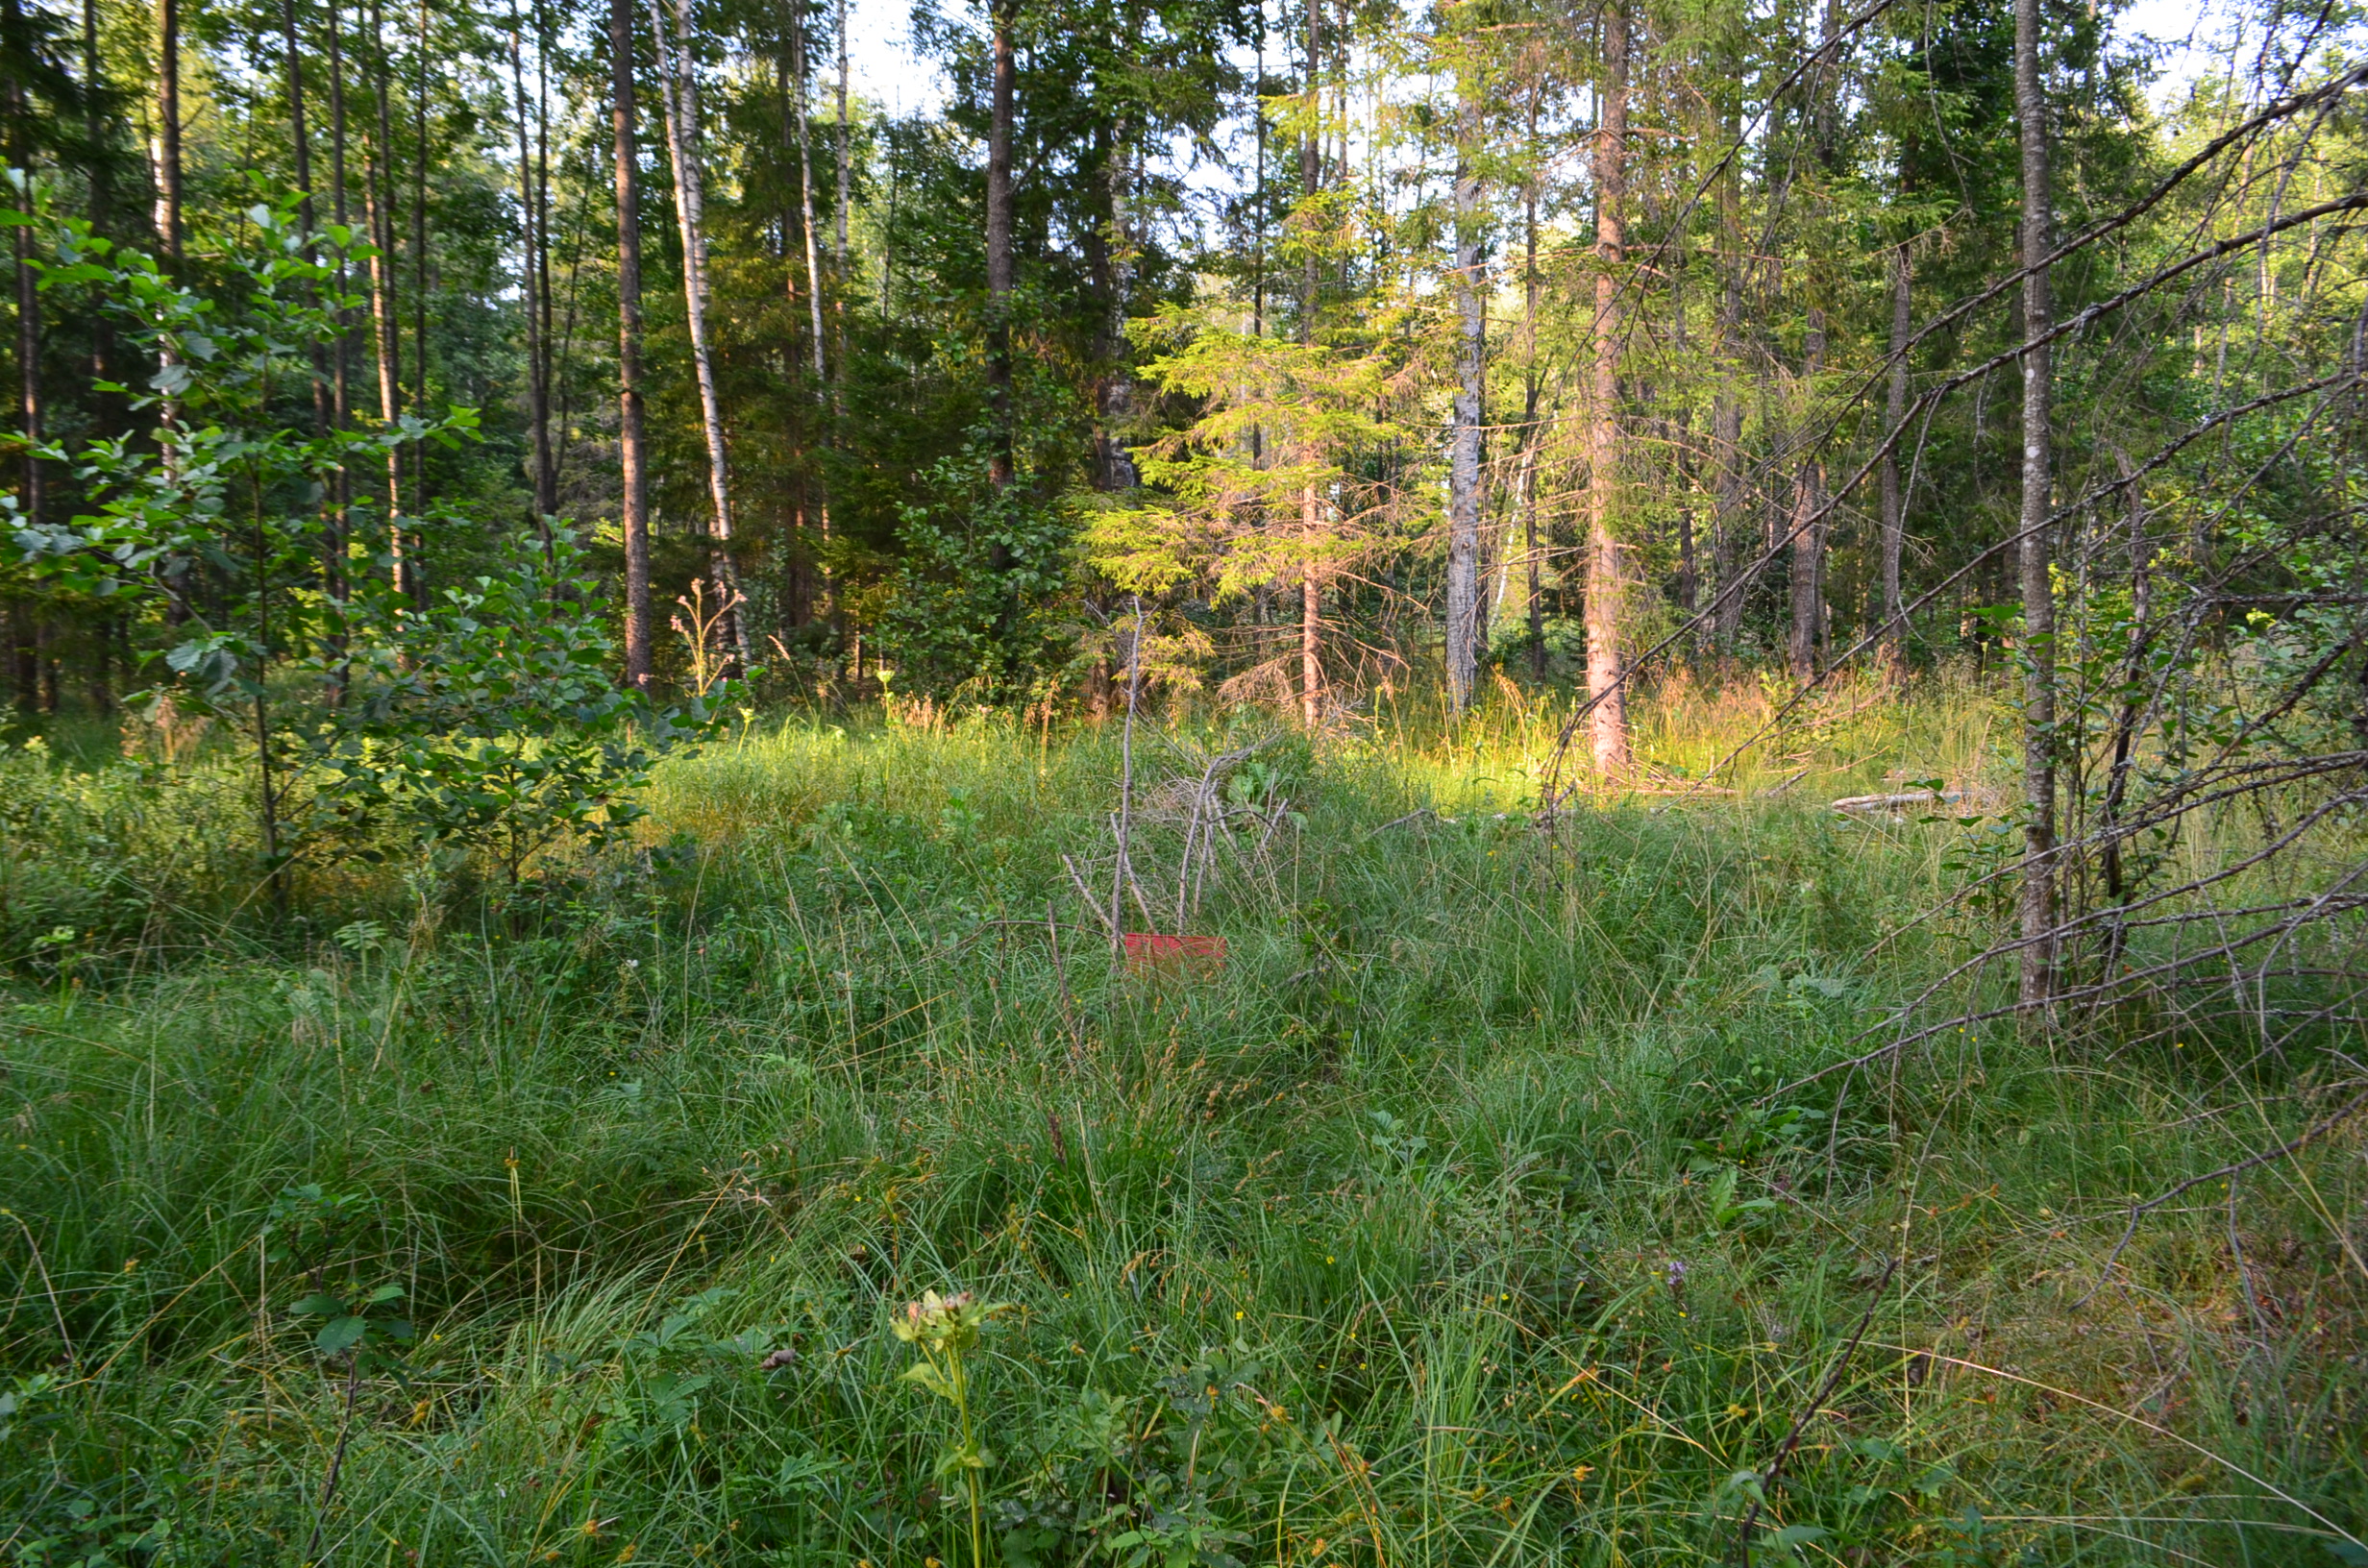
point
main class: Woodland
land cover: Spruce dominated mixed woodland
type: hemiboreal forest and nemoral coniferous forest and mixed broadleaved-coniferous forest
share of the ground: 50 - 75 %
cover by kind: coniferous forest trees 30 %, broadleaved forest trees 30 %, shrubs 20 %, herbaceous plants 20 %
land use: Forestry
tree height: > 5 m
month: August
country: LV
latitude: 57.2696
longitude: 21.9014
